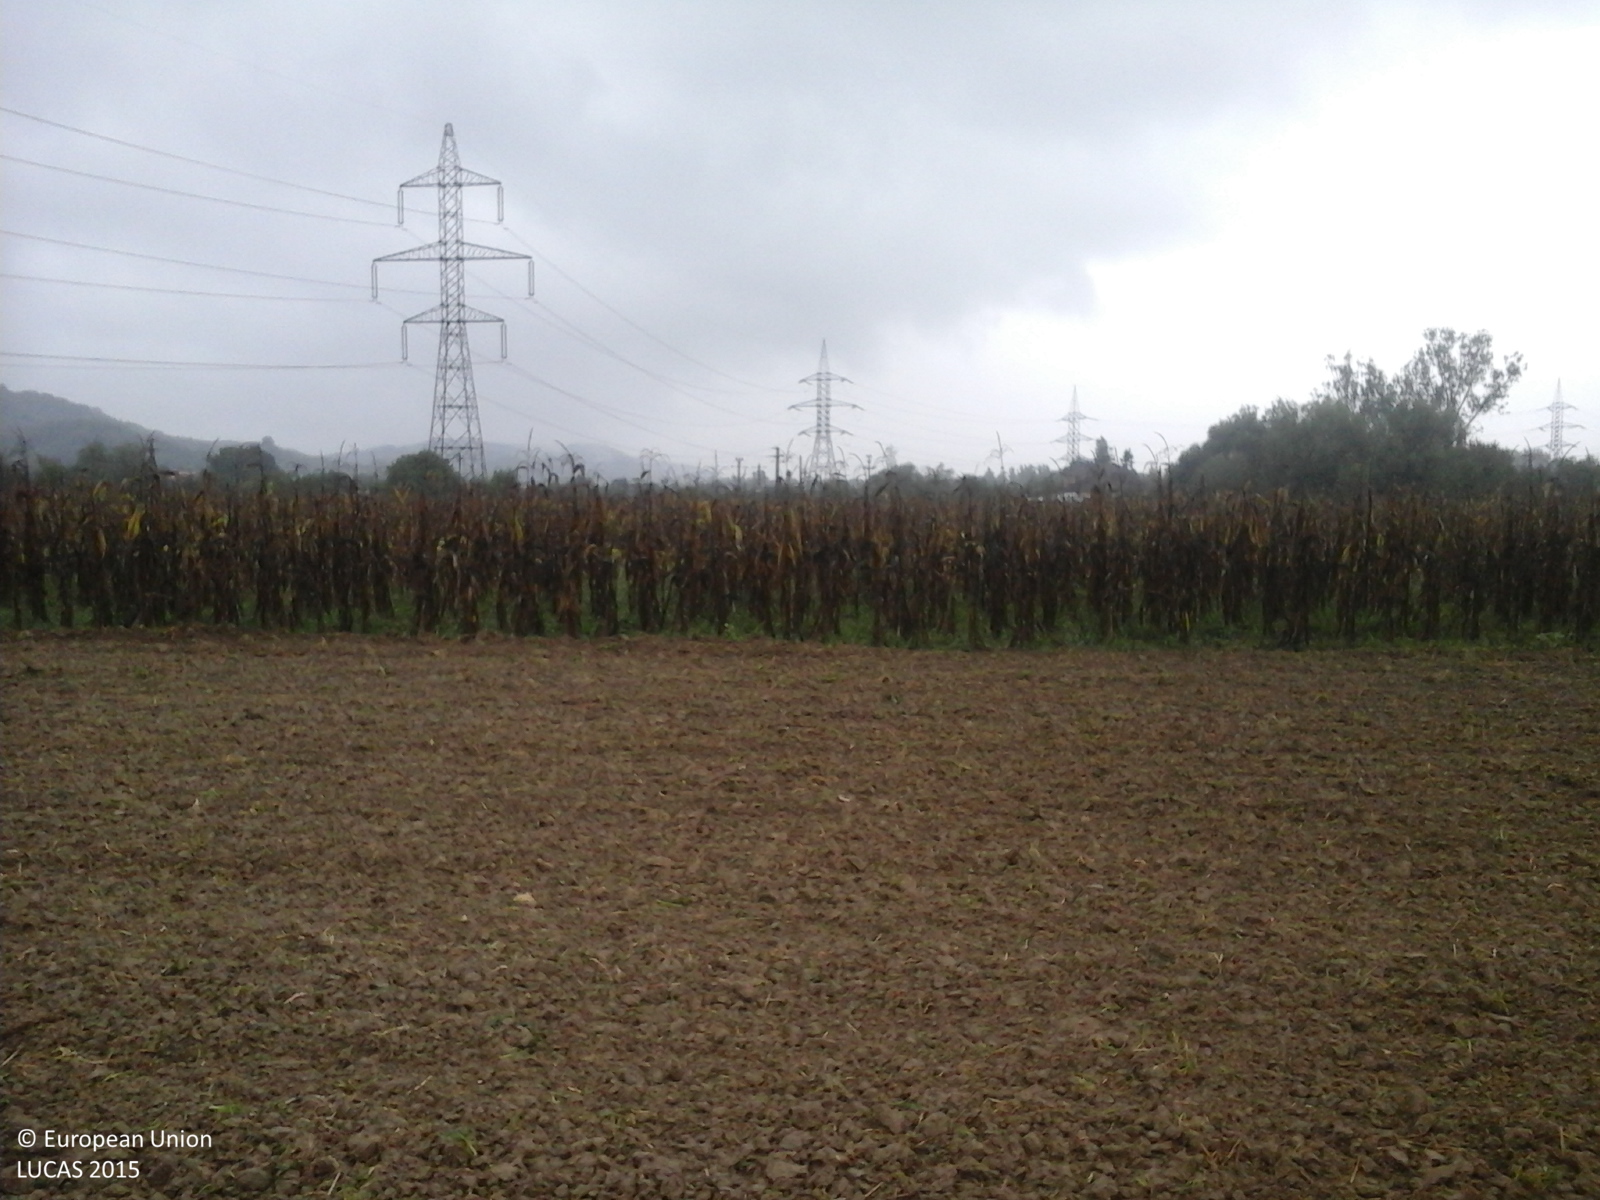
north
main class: Cropland
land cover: Common wheat
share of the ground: < 10 %
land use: Agriculture (excluding fallow land and kitchen gardens)
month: September
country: RO
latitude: 44.8686
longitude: 23.5108
